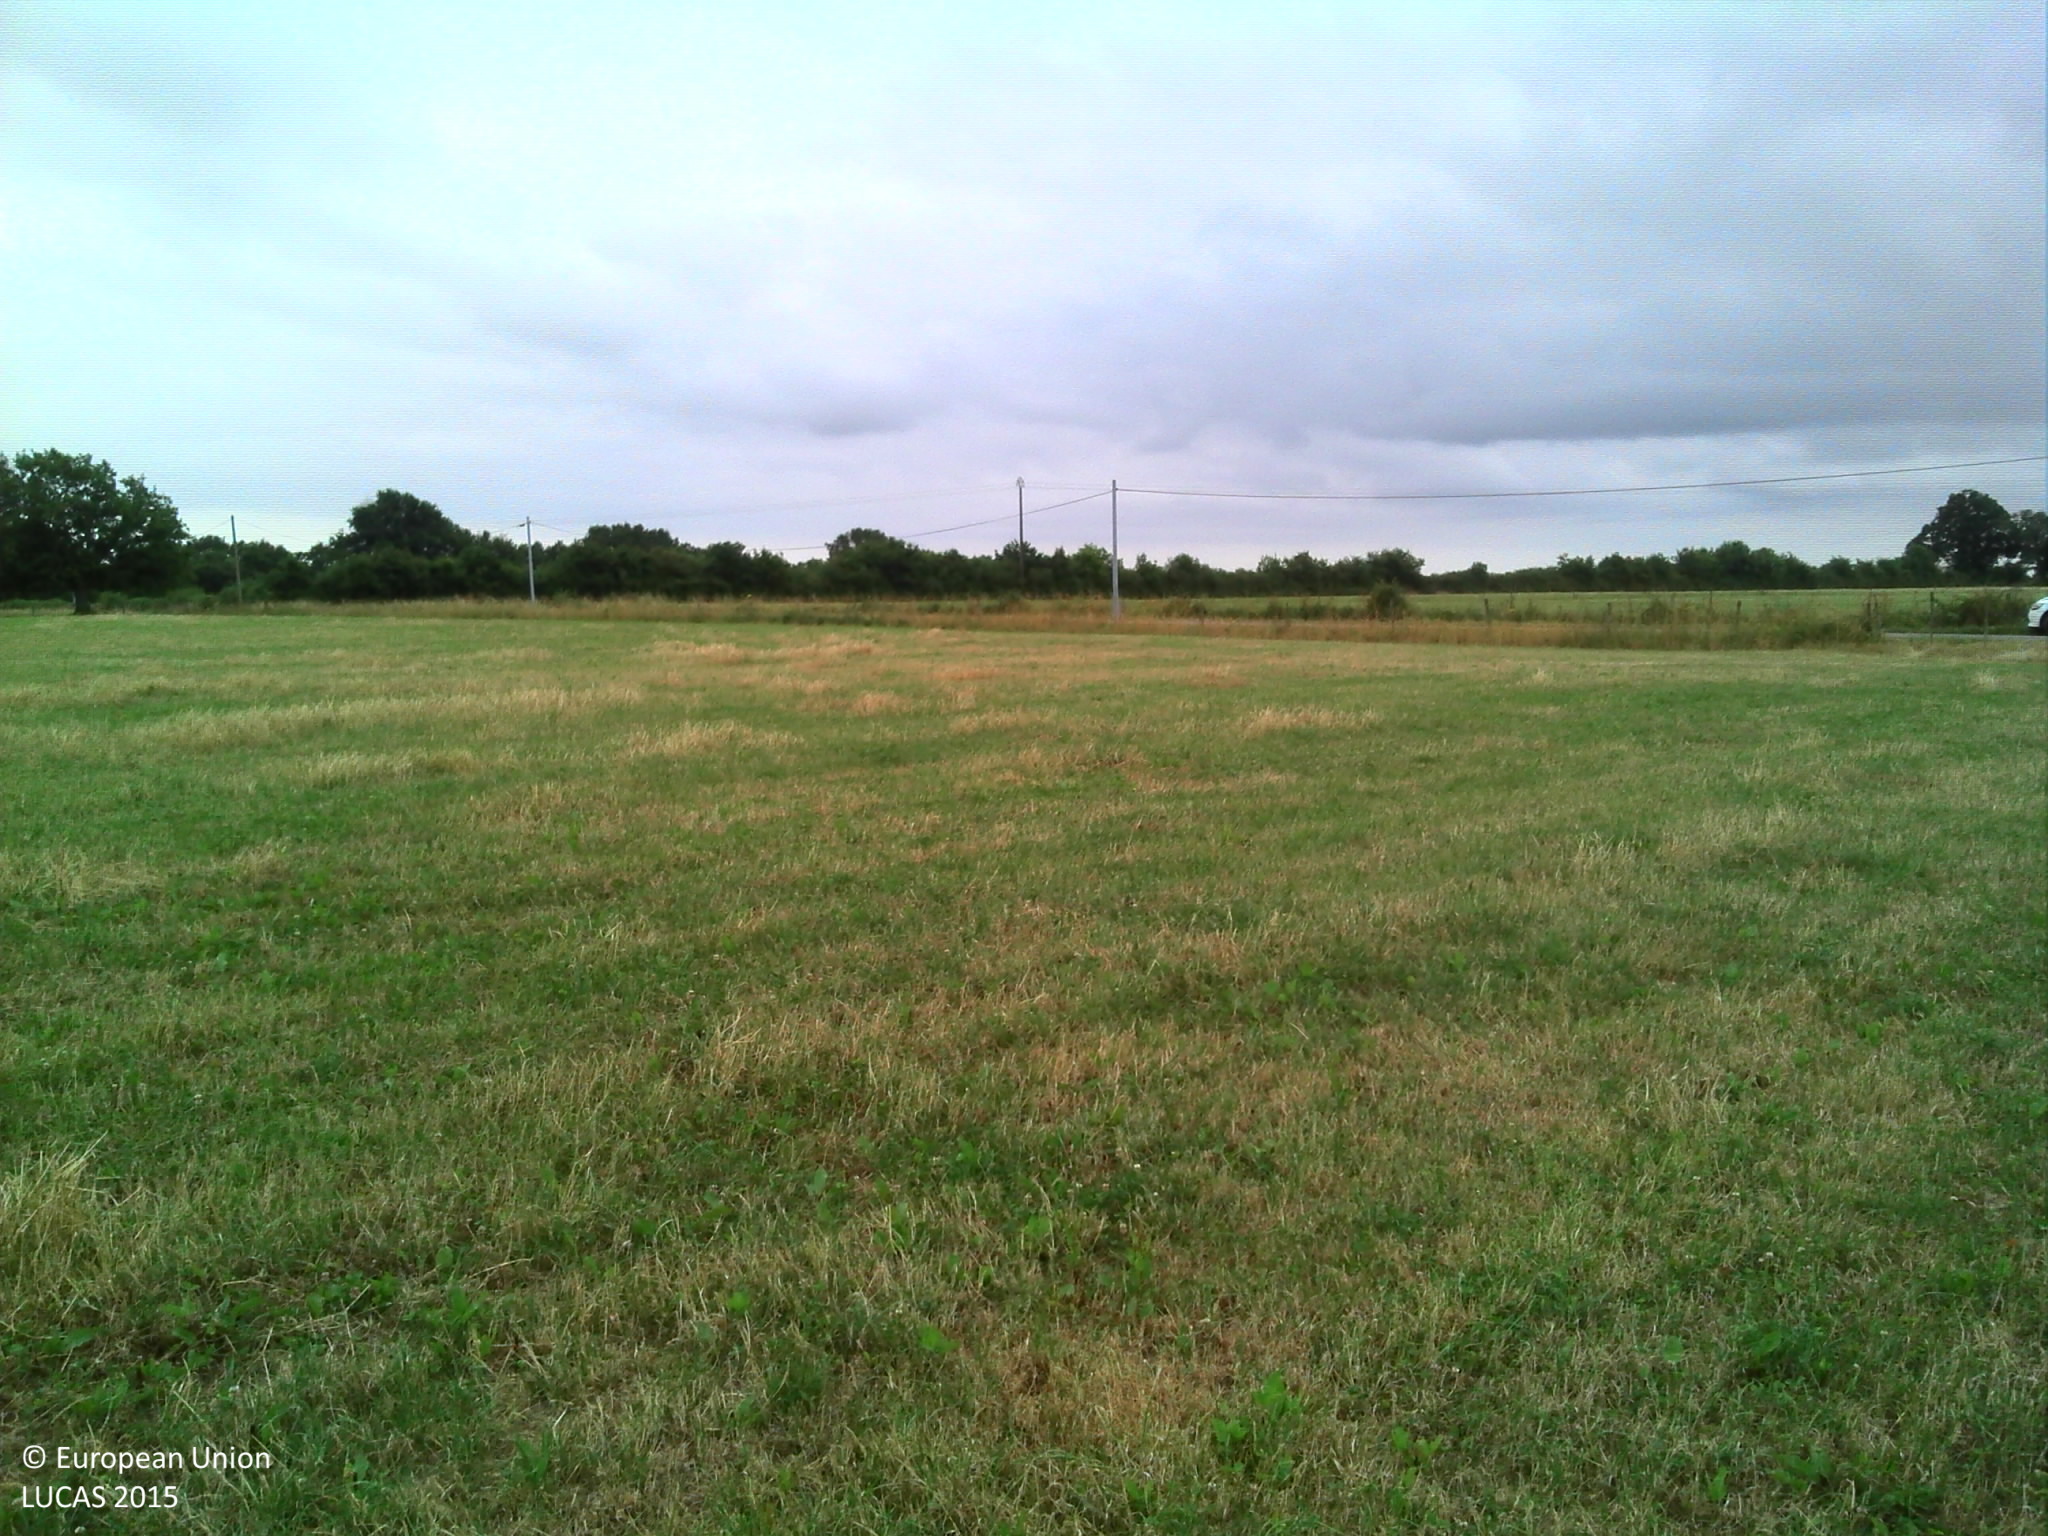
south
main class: Cropland
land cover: Temporary grasslands
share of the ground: > 75 %
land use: Agriculture (excluding fallow land and kitchen gardens)
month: July
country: FR
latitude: 47.1101
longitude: -1.8399
